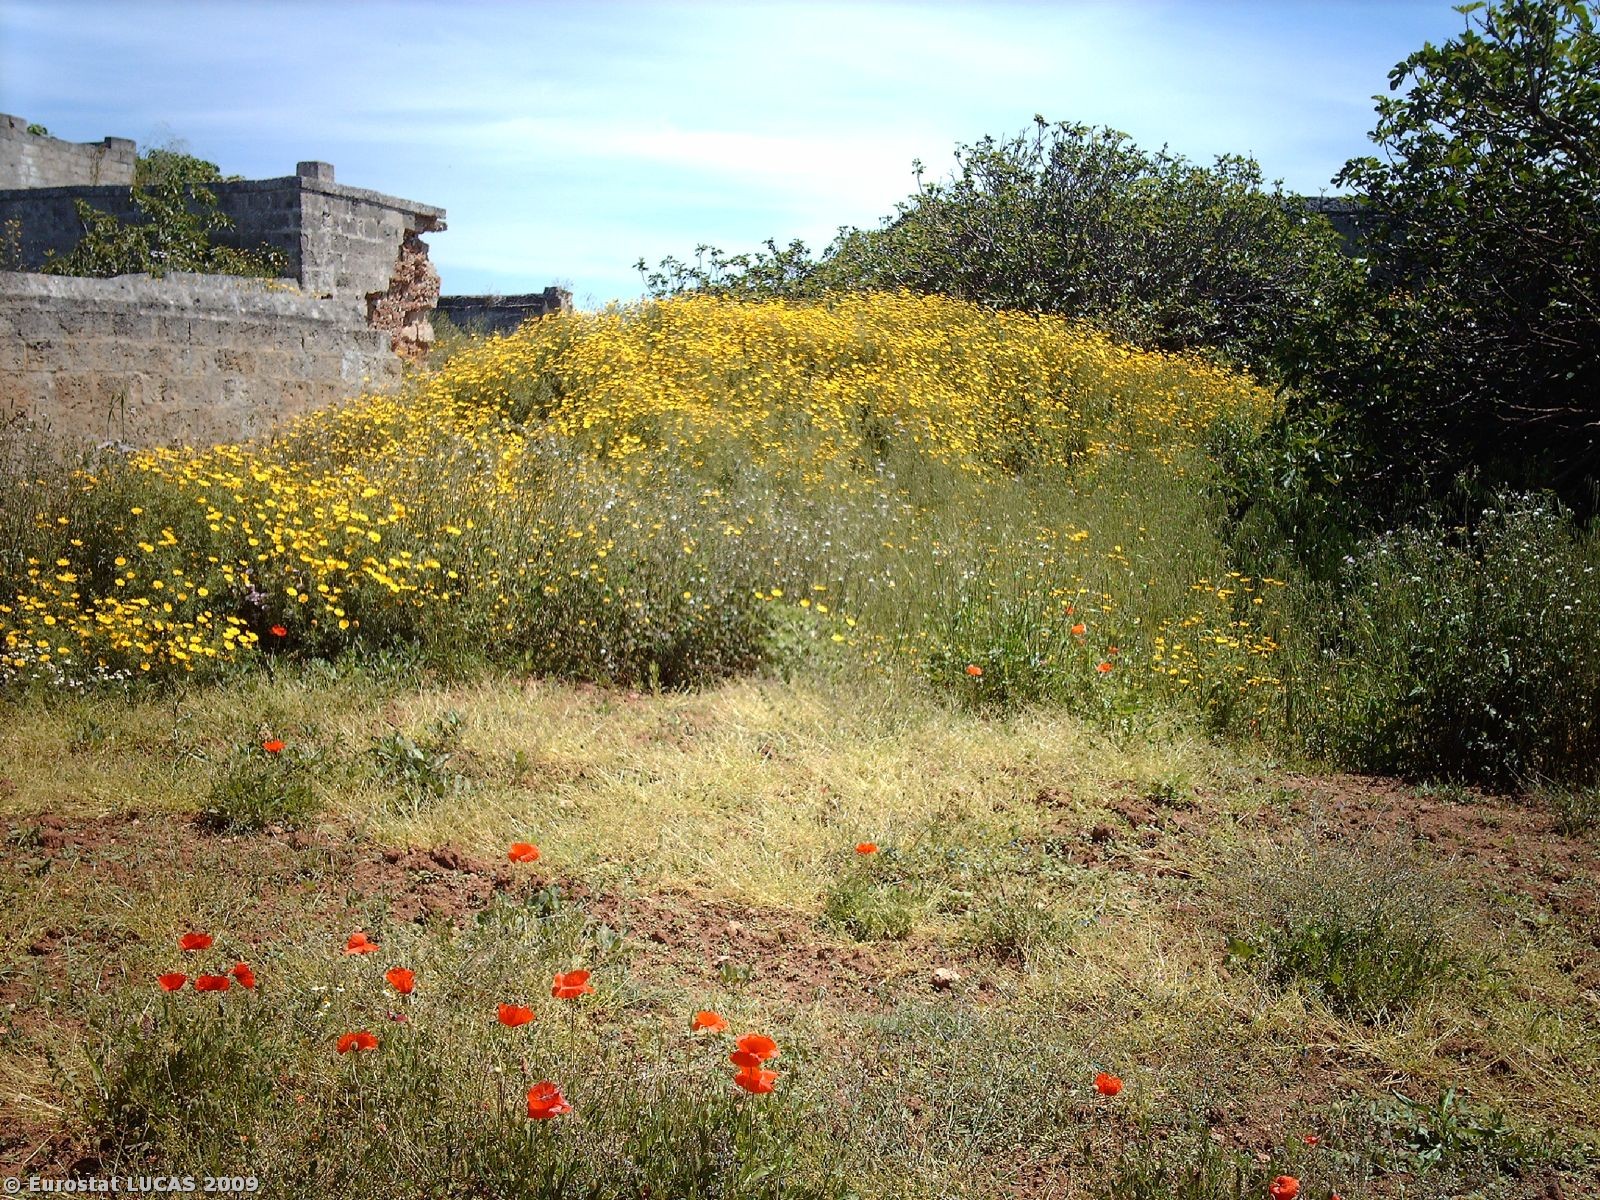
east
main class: Grassland
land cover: Spontaneously vegetated surfaces
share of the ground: > 75 %
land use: Fallow land
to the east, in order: Spontaneously vegetated surfaces; Artificial constructions; Spontaneously vegetated surfaces; Artificial constructions in urban areas; Spontaneously vegetated surfaces; Artificial constructions in urban areas; Fences; Other fruit trees and berries; Paved roads, cycling and walking lanes
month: May
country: IT
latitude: 40.7916
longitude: 17.5744
